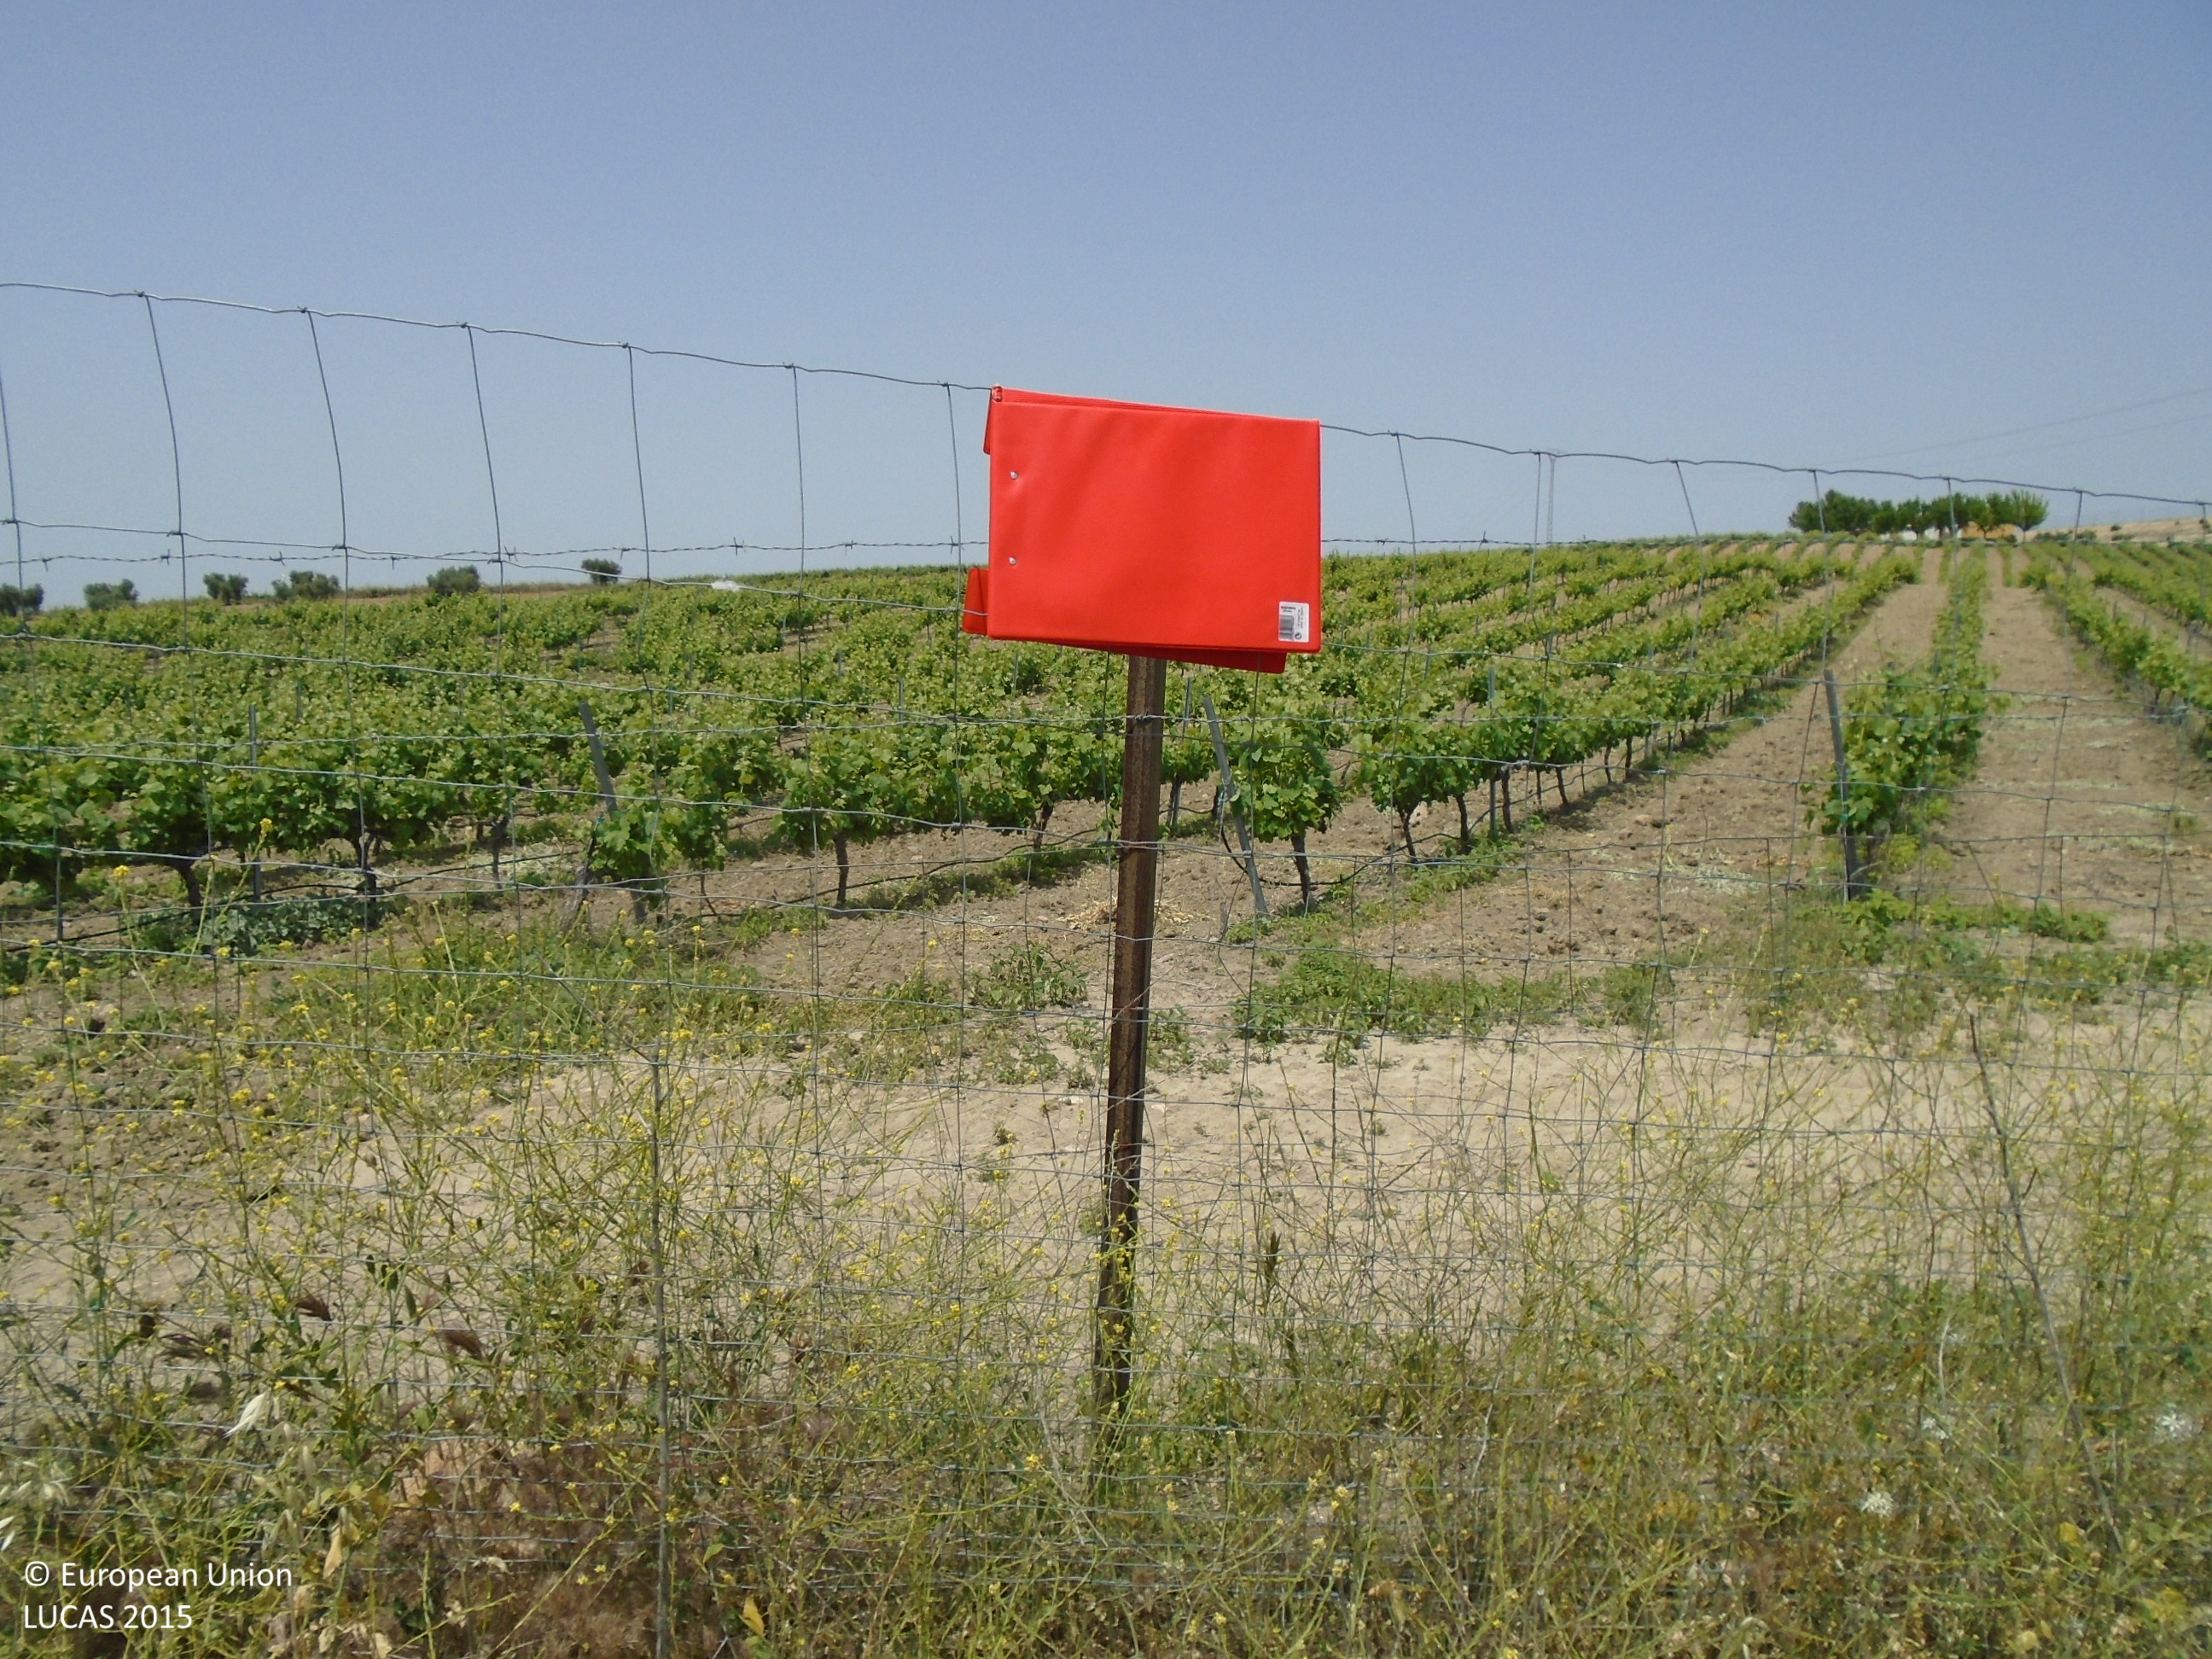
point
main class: Cropland
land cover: Vineyards
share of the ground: 10 - 25 %
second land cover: Other bare soil
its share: > 75 %
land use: Agriculture (excluding fallow land and kitchen gardens)
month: May
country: ES
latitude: 39.7885
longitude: -4.6270
